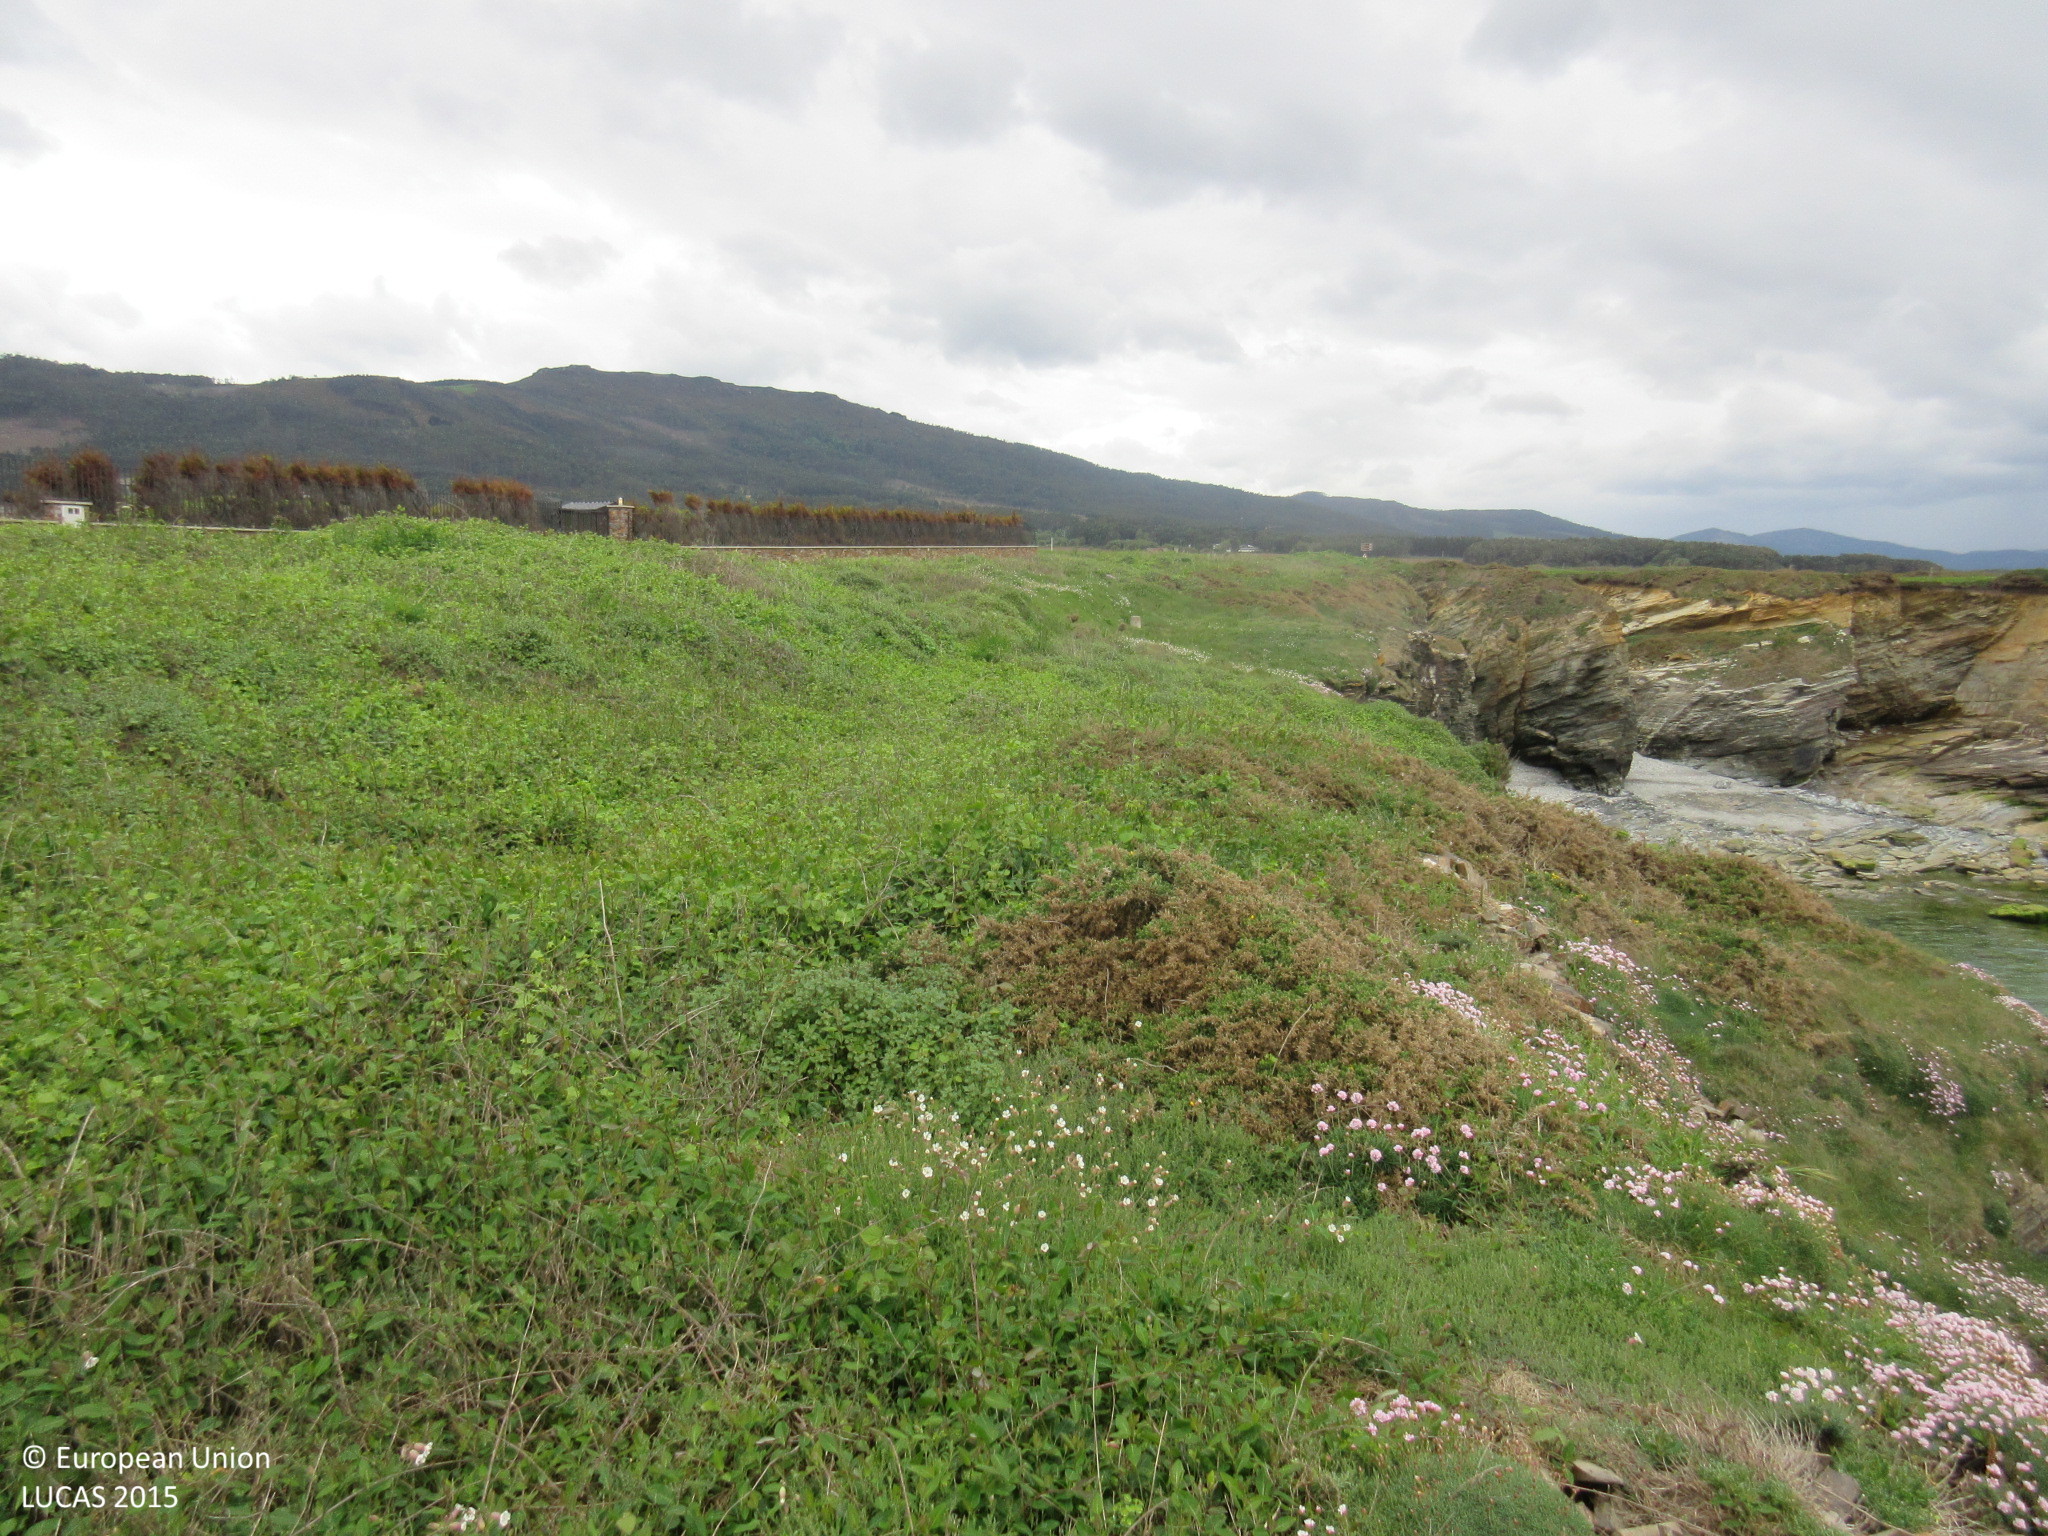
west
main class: Shrubland
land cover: Shrubland without tree cover
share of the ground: > 75 %
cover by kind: herbaceous plants 80 %, shrubs 20 %
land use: Semi-natural and natural areas not in use
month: April
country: ES
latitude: 43.5553
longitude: -7.1427
